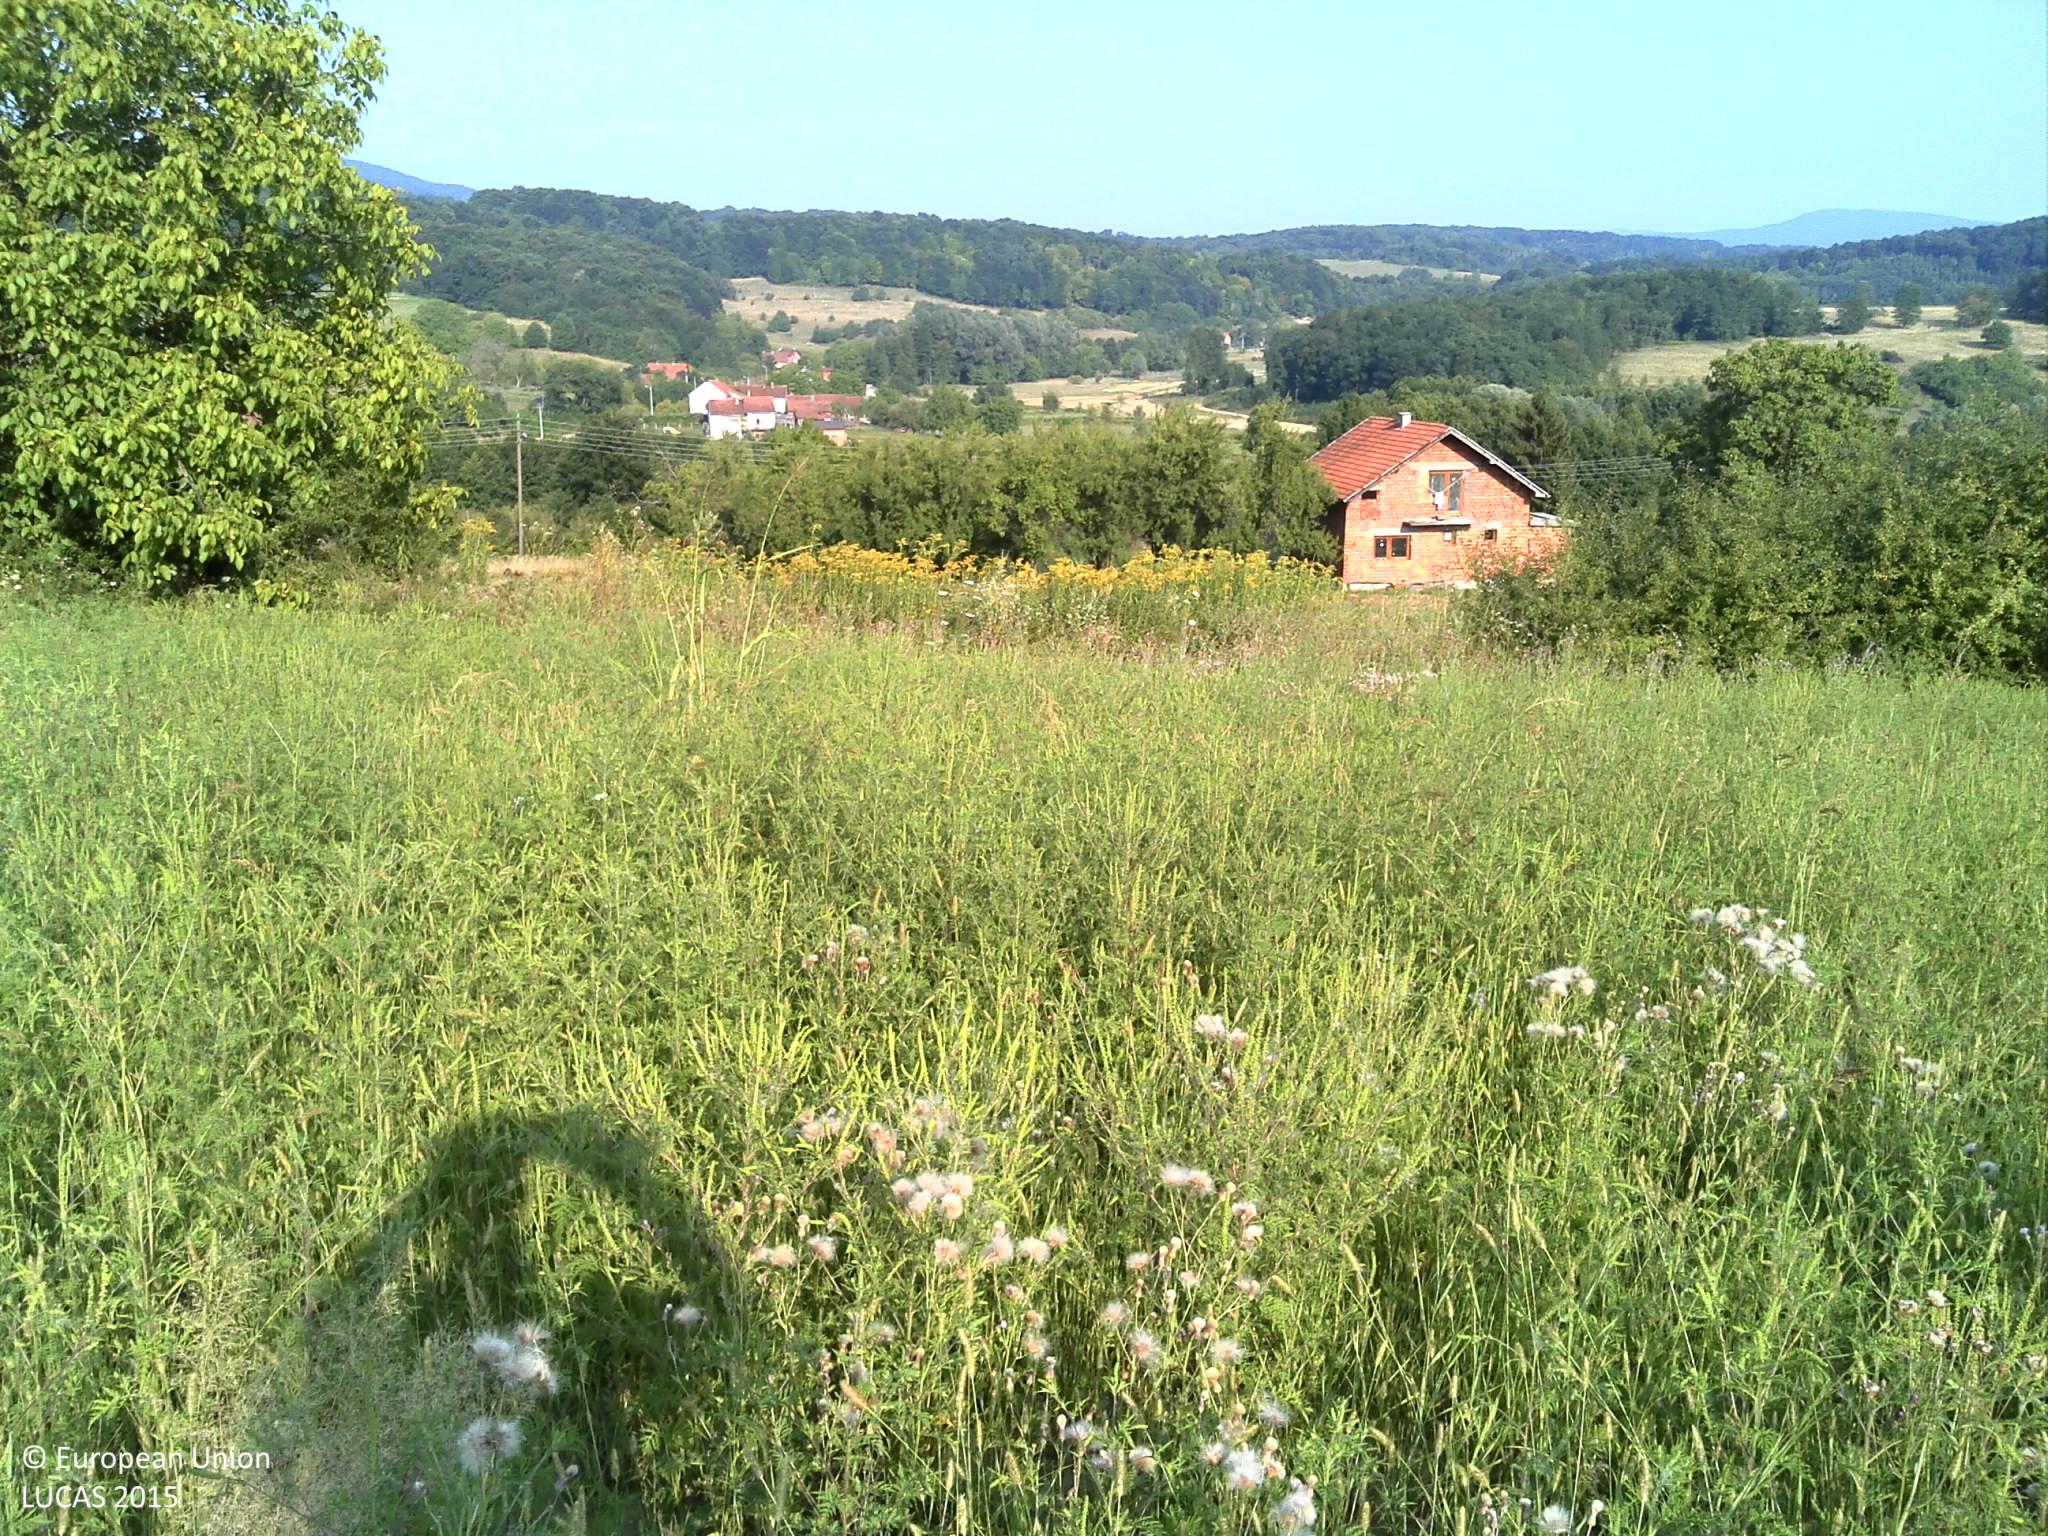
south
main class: Woodland
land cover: Broadleaved woodland
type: acidophilous oak and oak-birch forest
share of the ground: > 75 %
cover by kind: broadleaved forest trees 100 %
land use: Forestry
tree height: > 5 m
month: August
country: HR
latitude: 45.5811
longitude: 17.2419
